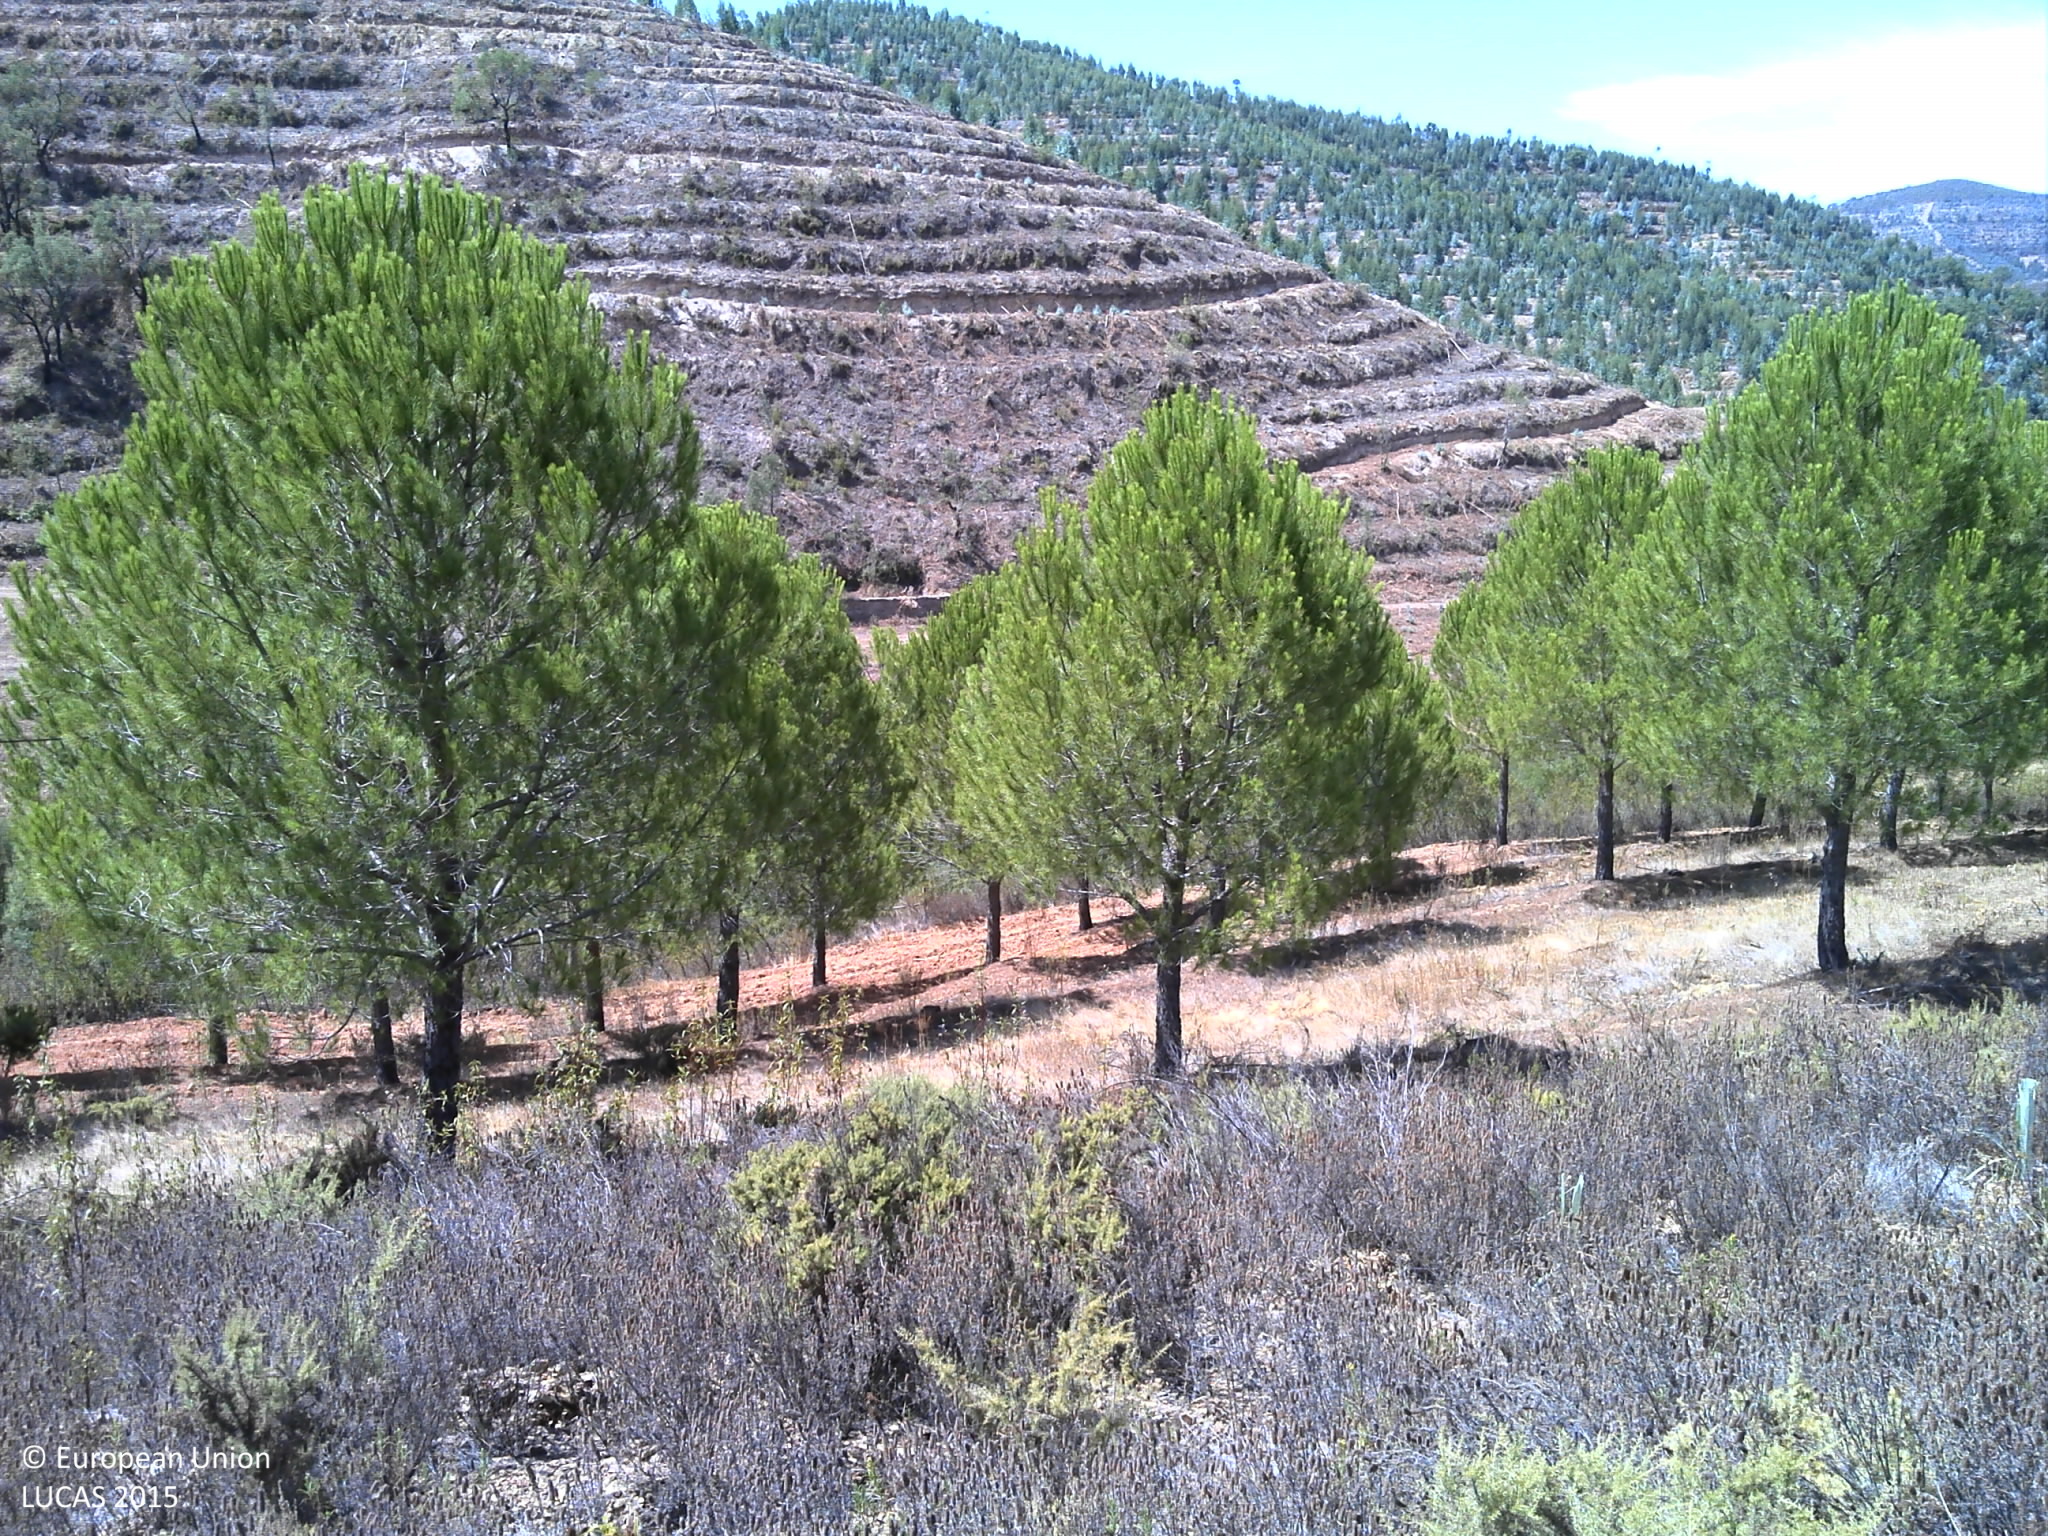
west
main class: Grassland
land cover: Grassland with sparse tree/shrub cover
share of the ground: 50 - 75 %
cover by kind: herbaceous plants 60 %, unconsolidated bare surface 35 %, broadleaved forest trees 5 %
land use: Forestry
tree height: < 5 m
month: September
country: PT
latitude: 37.3664
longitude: -8.1899
